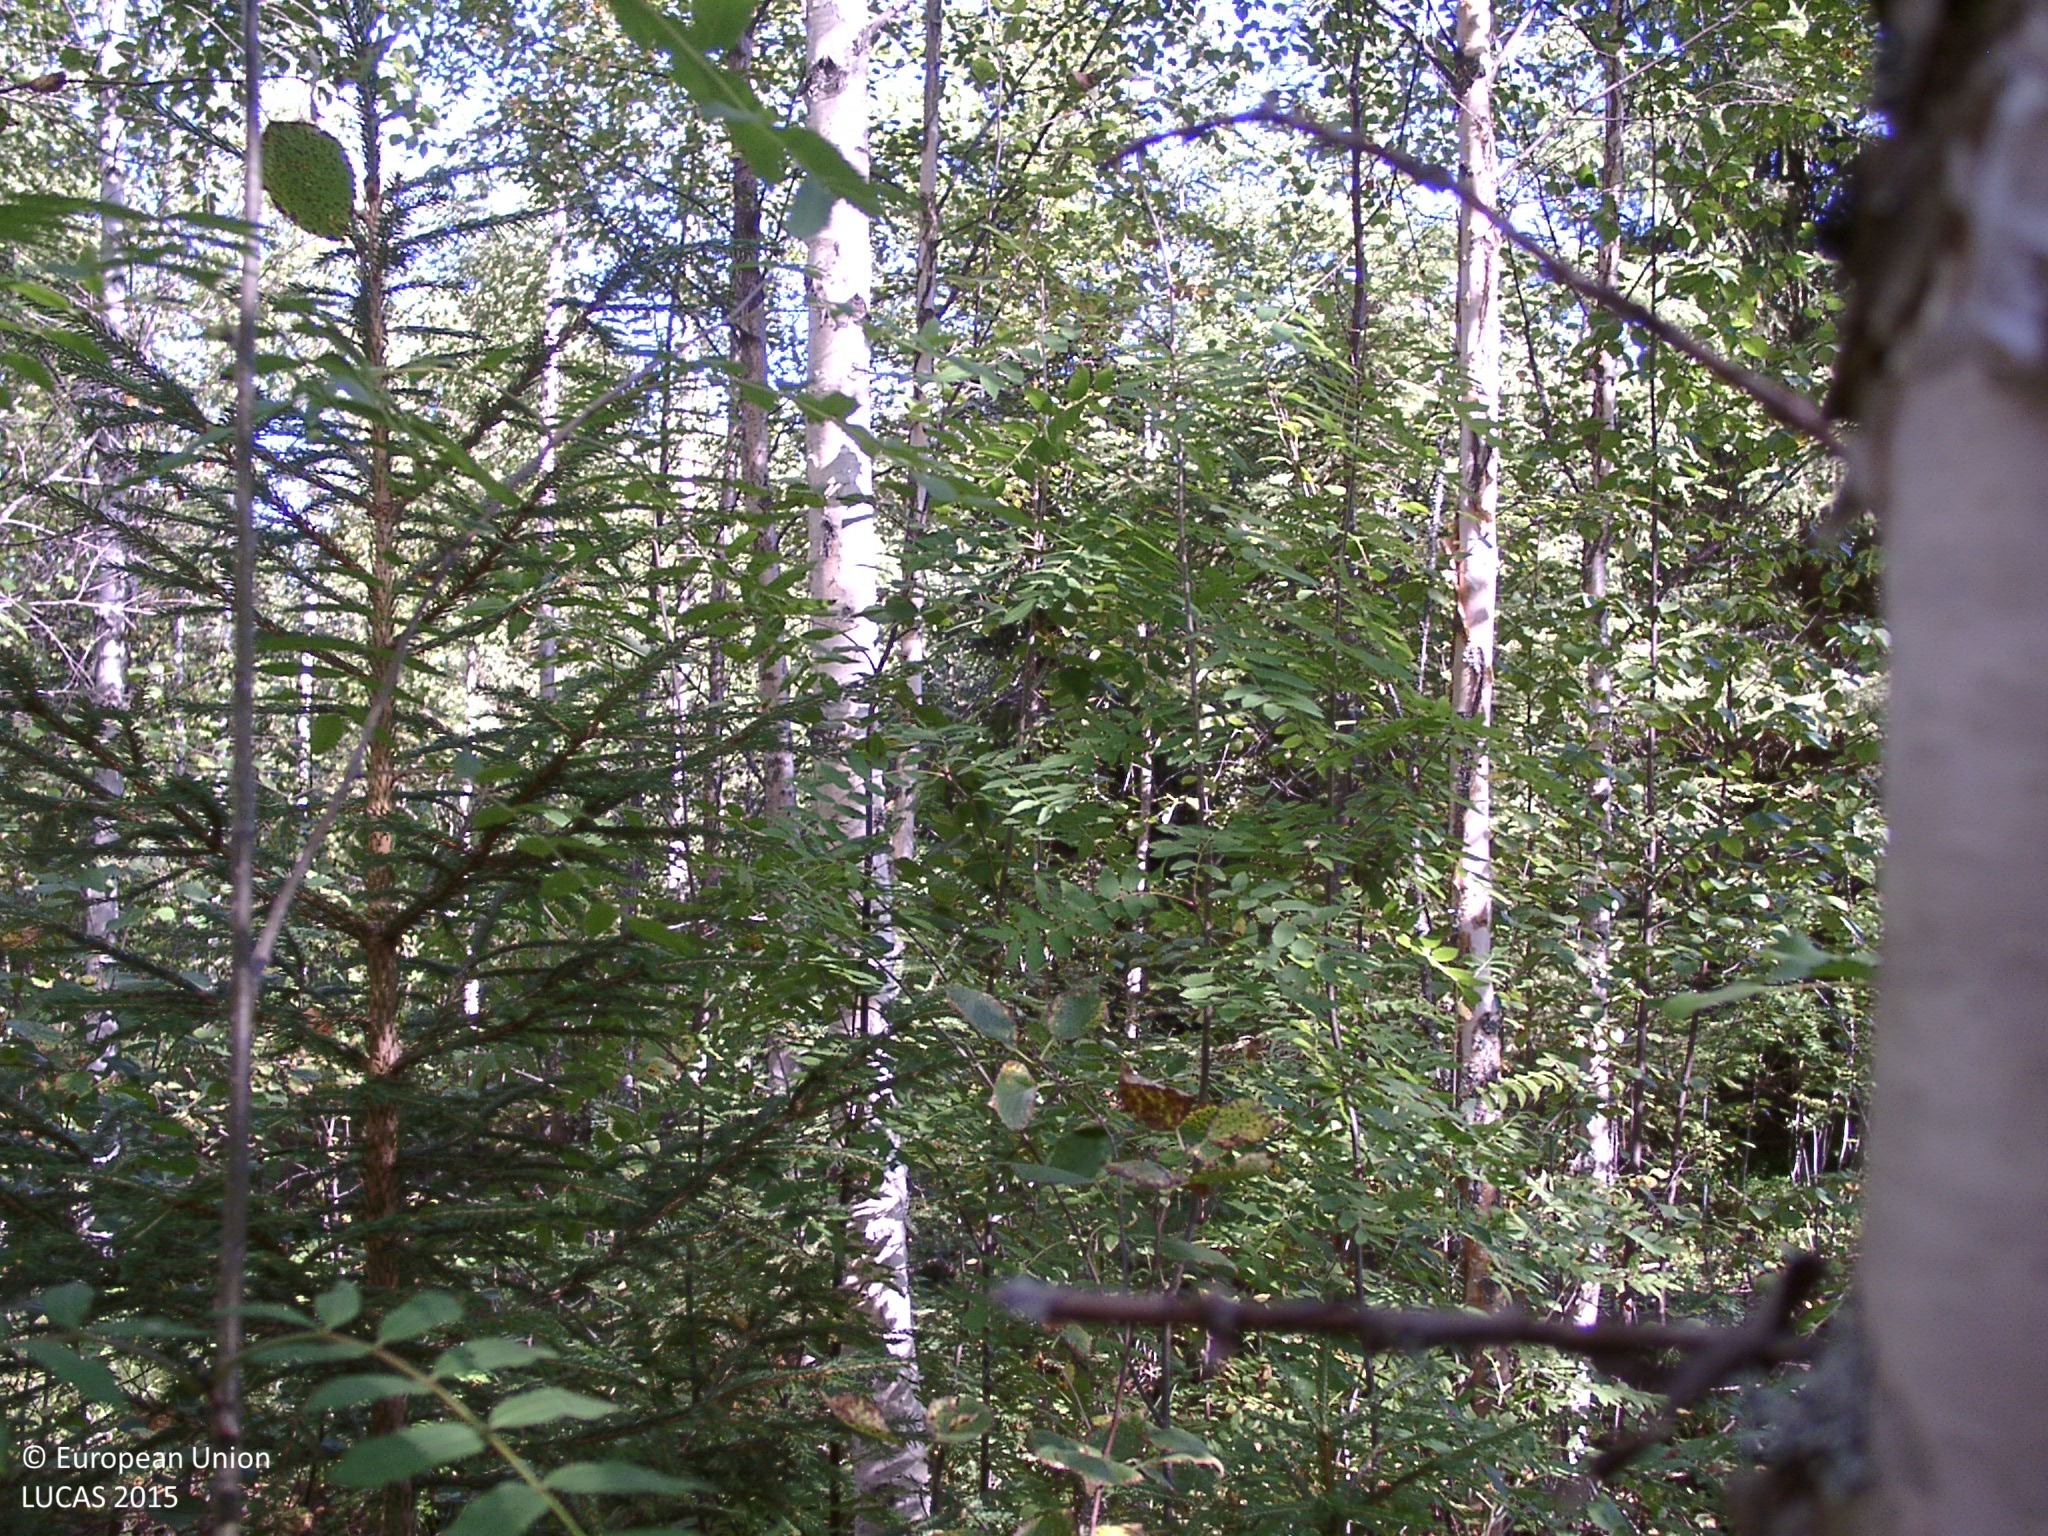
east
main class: Woodland
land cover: Broadleaved woodland
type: boreal forest
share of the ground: > 75 %
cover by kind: broadleaved forest trees 65 %, coniferous forest trees 20 %, shrubs 10 %, unconsolidated bare surface 5 %
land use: Forestry
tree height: > 5 m
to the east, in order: Broadleaved woodland; Ditches and canals; Groves; Spruce dominated mixed woodland; Ditches and canals; Broadleaved woodland; Electric lines; Shrubland with sparse tree cover; Broadleaved woodland; Ditches and canals; Broadleaved woodland; Spruce dominated mixed woodland; Ditches and canals; Spruce dominated mixed woodland; Ditches and canals; Groves; Tracks; Spruce dominated coniferous woodland; Tracks; Spruce dominated coniferous woodland; Groves; Ditches and canals; Grass margins; Temporary grasslands
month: August
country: FI
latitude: 62.4092
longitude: 25.3403
